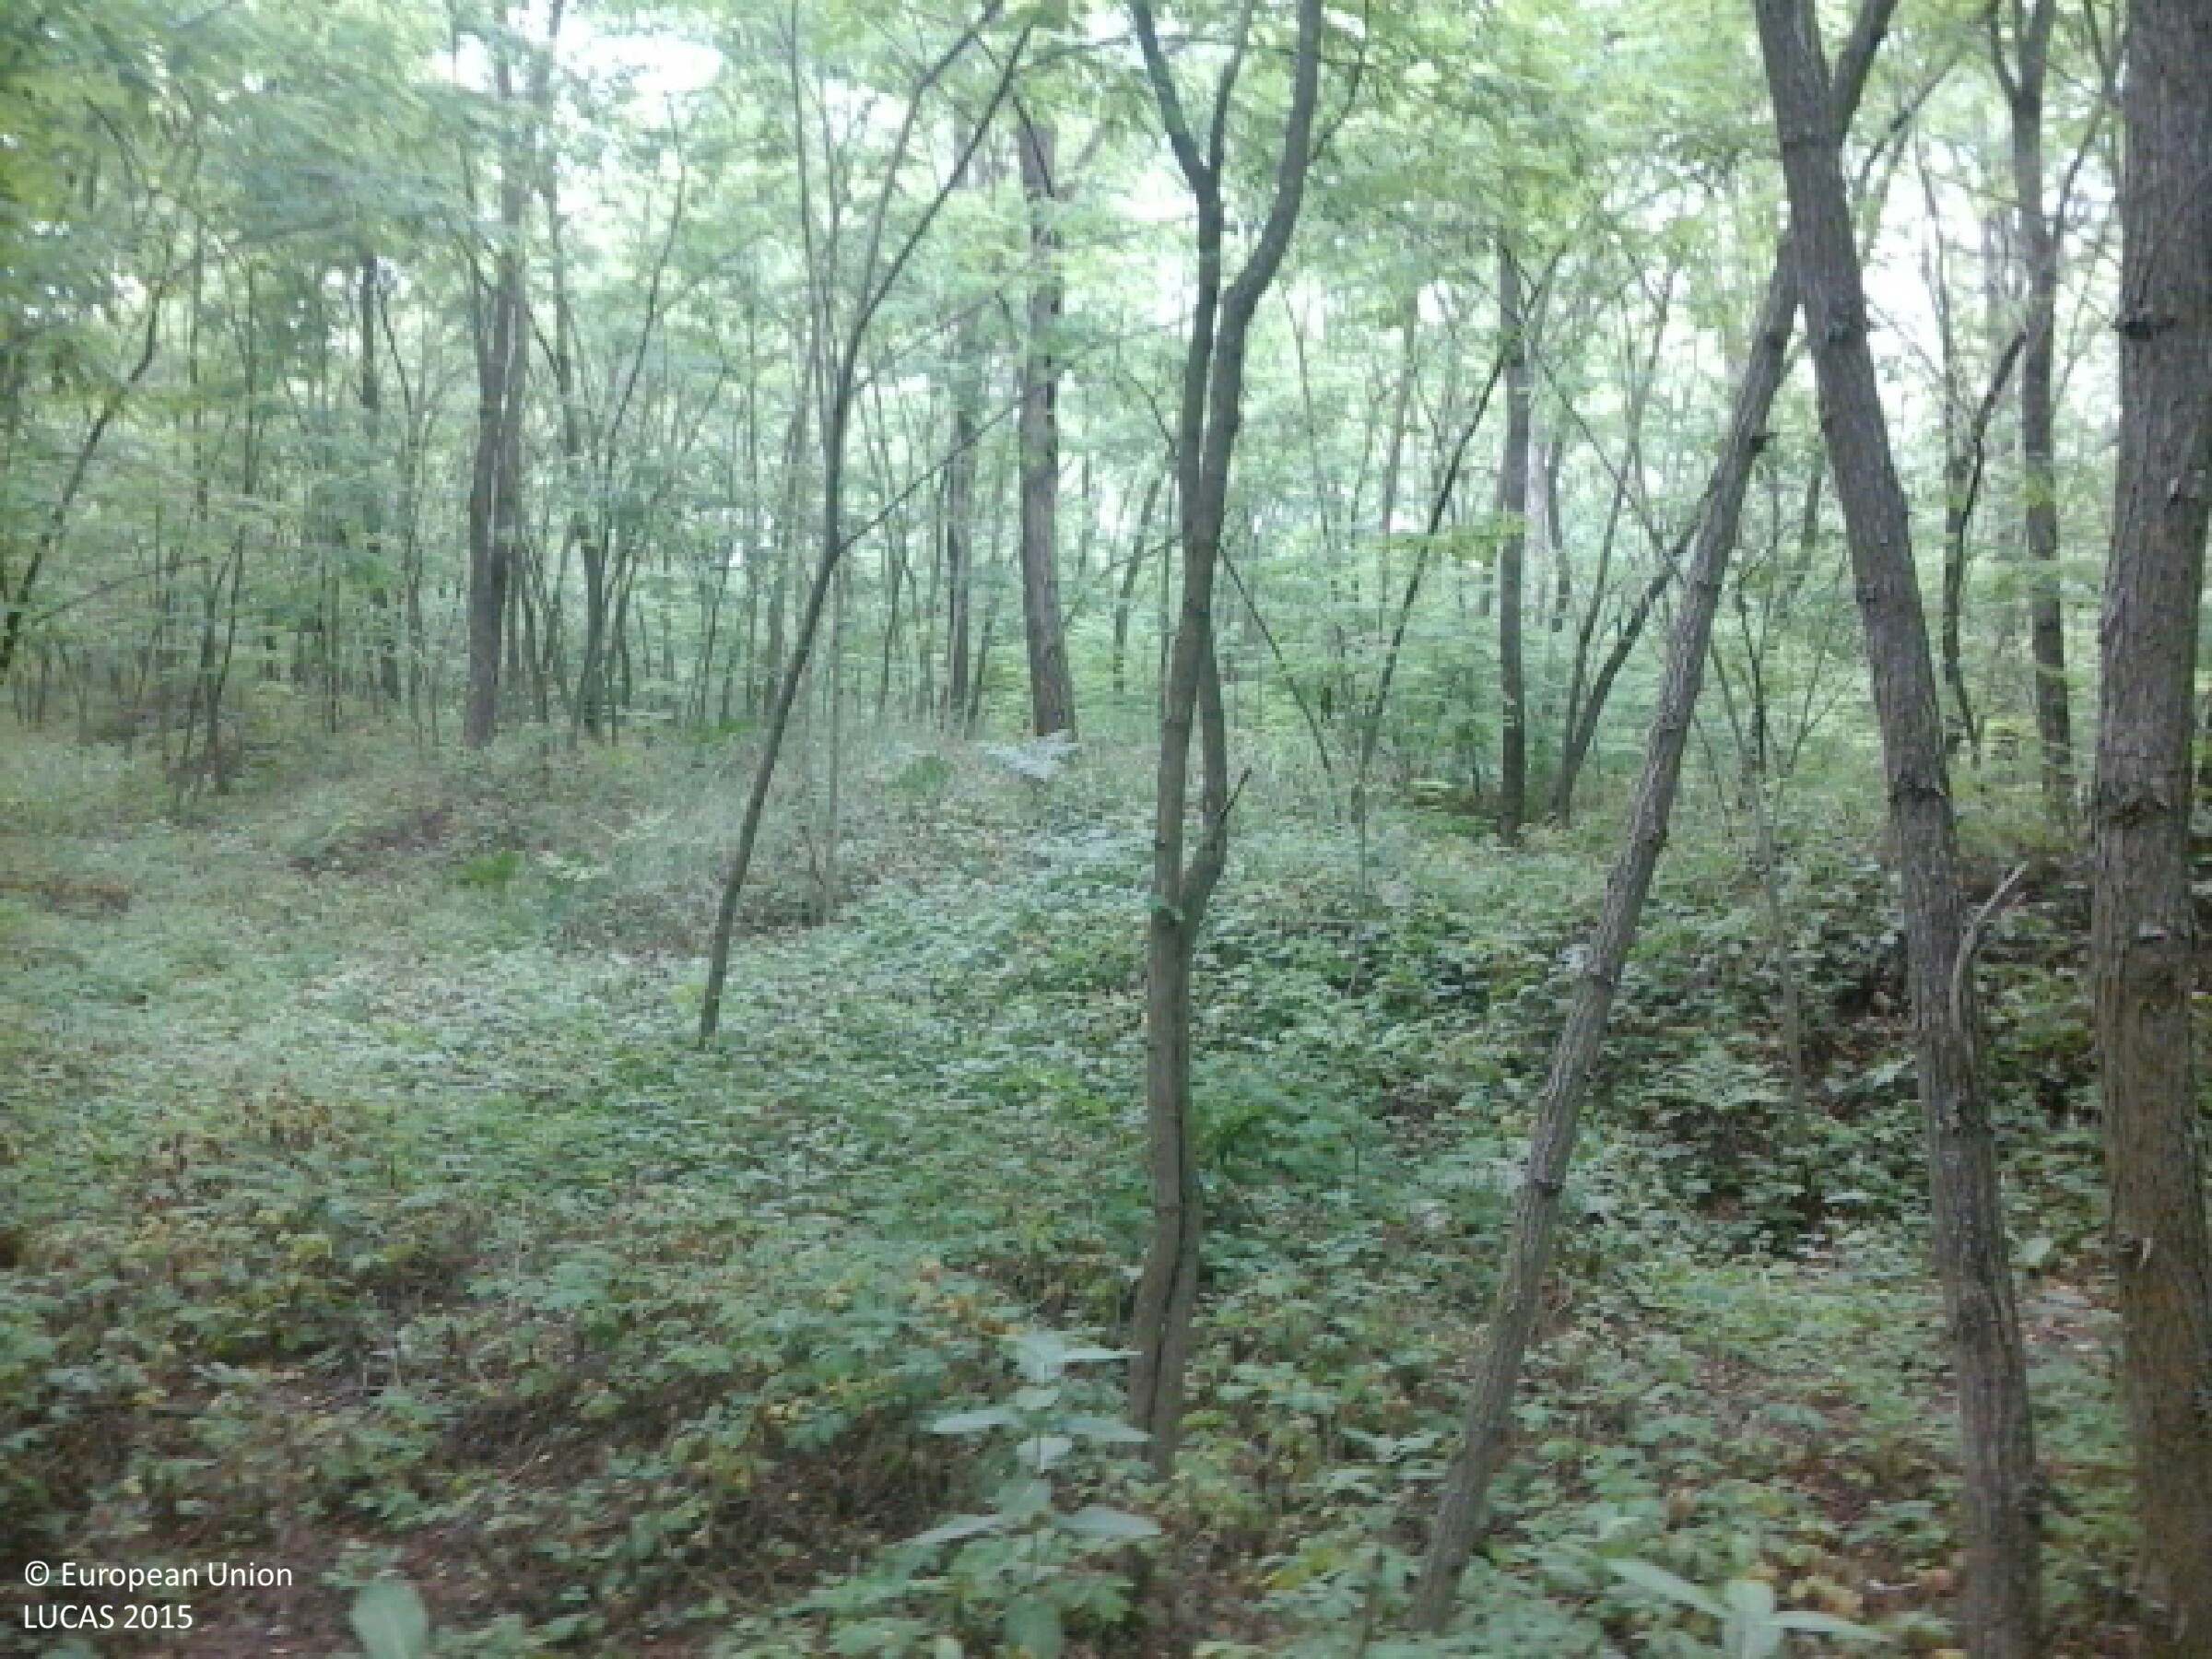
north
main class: Woodland
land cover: Broadleaved woodland
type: exotic forest
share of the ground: > 75 %
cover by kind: broadleaved forest trees 80 %, herbaceous plants 15 %, shrubs 5 %
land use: Forestry
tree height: > 5 m
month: June
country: HU
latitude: 48.1060
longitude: 22.2098
